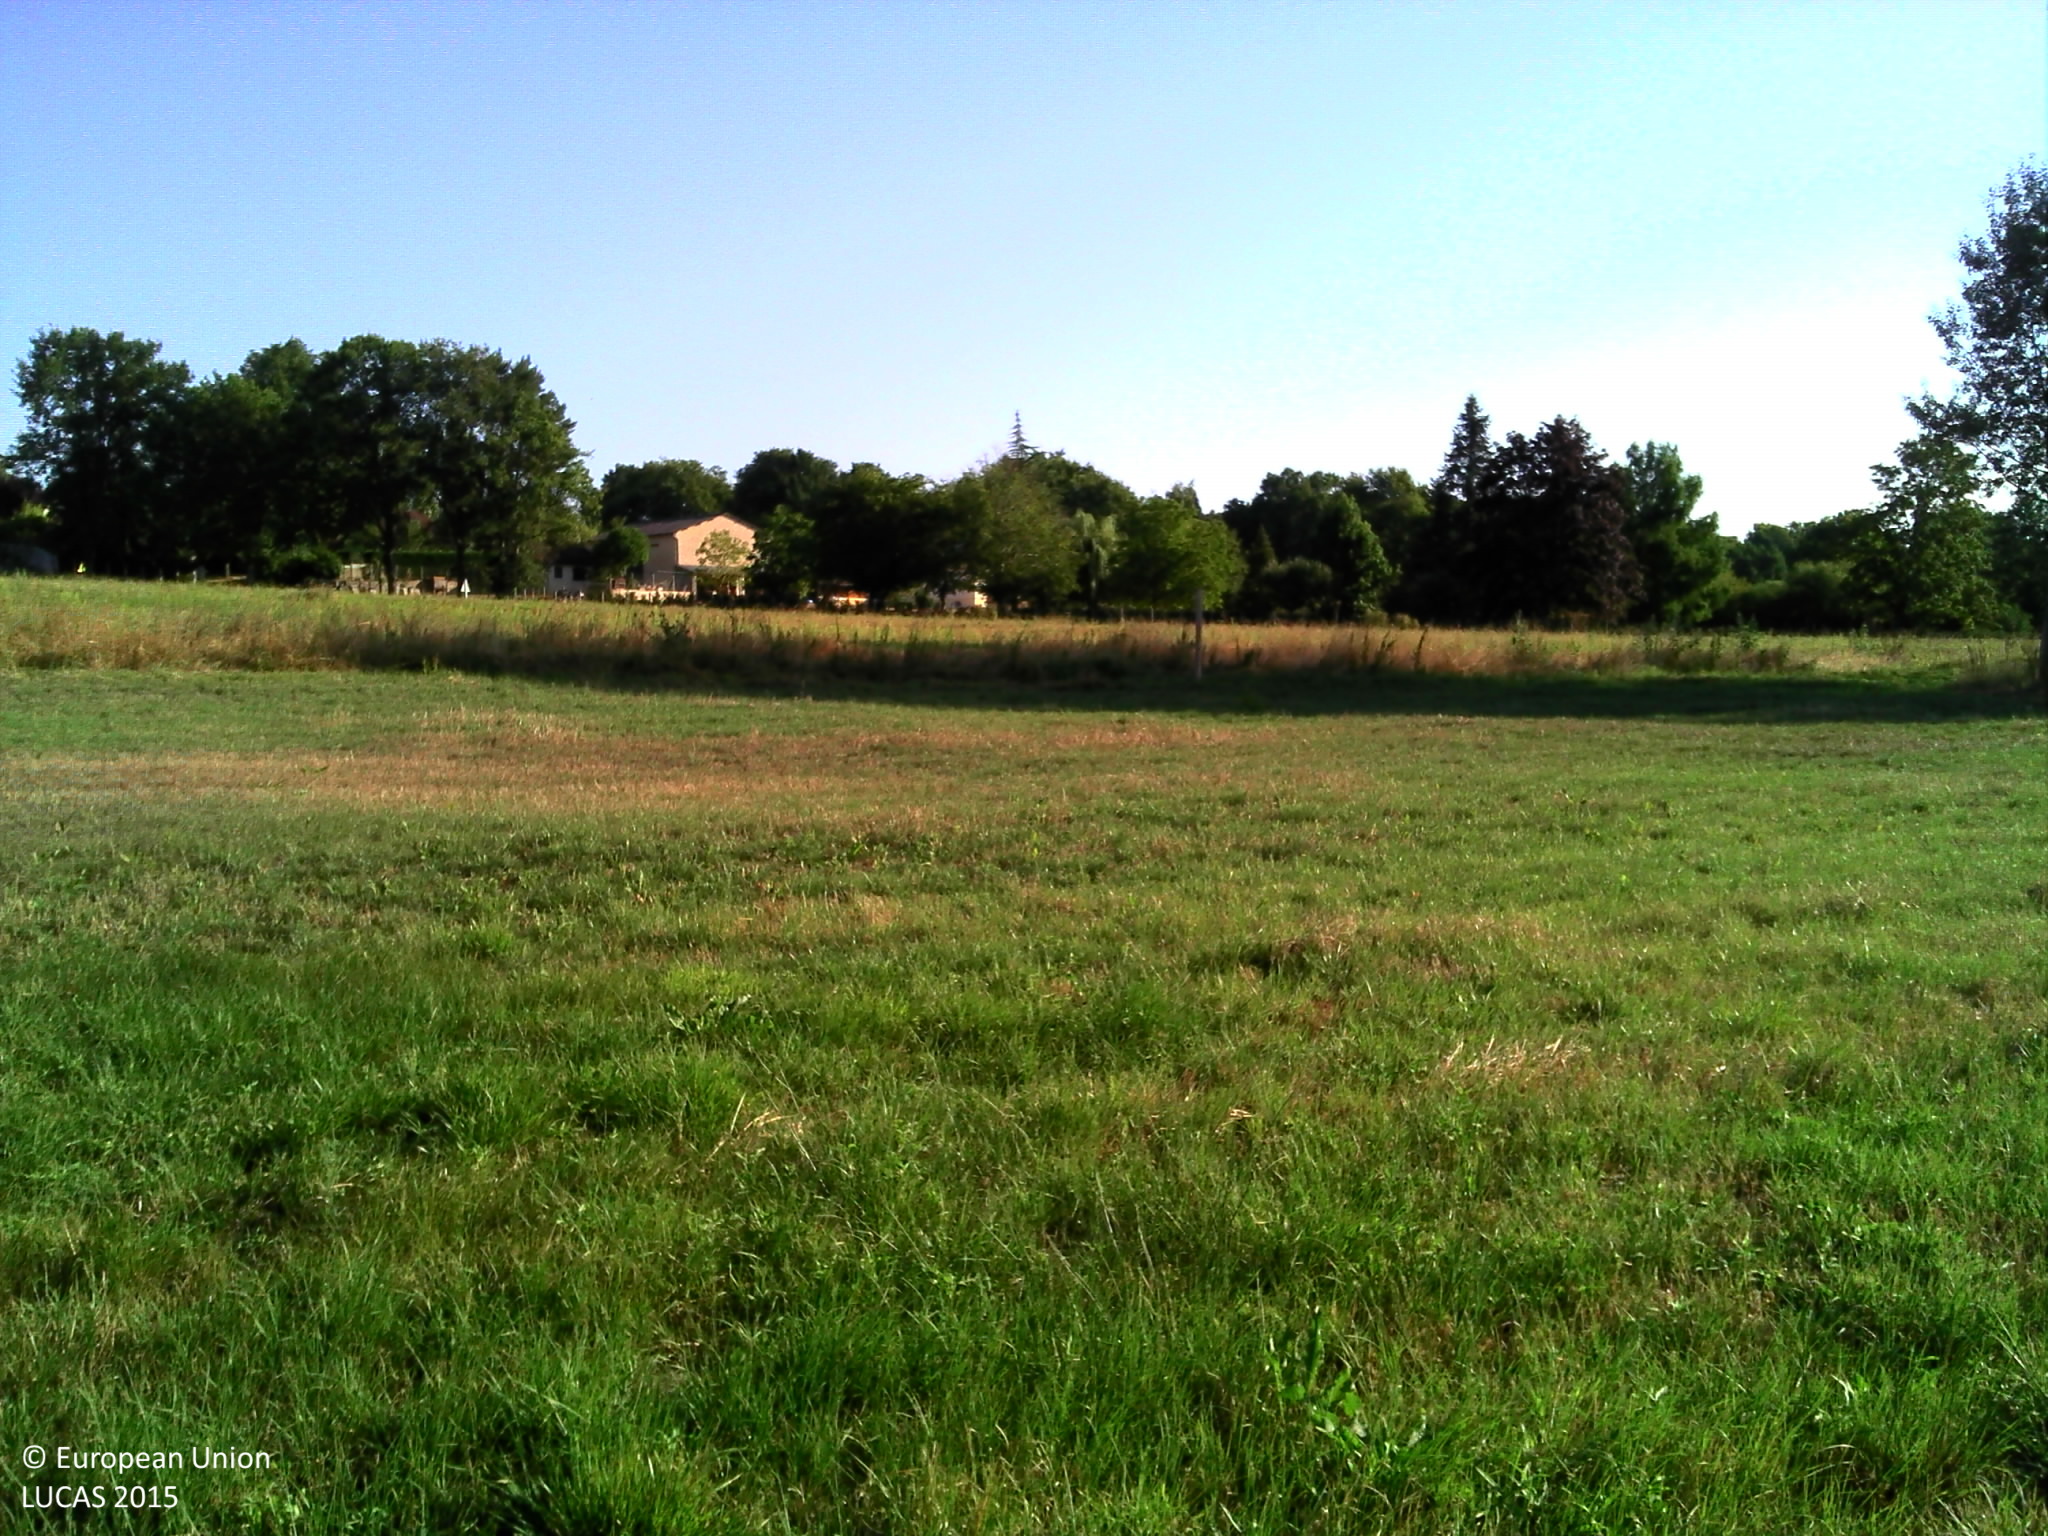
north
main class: Grassland
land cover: Grassland without tree/shrub cover
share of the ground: > 75 %
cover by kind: herbaceous plants 100 %
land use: Agriculture (excluding fallow land and kitchen gardens)
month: August
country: FR
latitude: 47.8130
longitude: 3.4649
